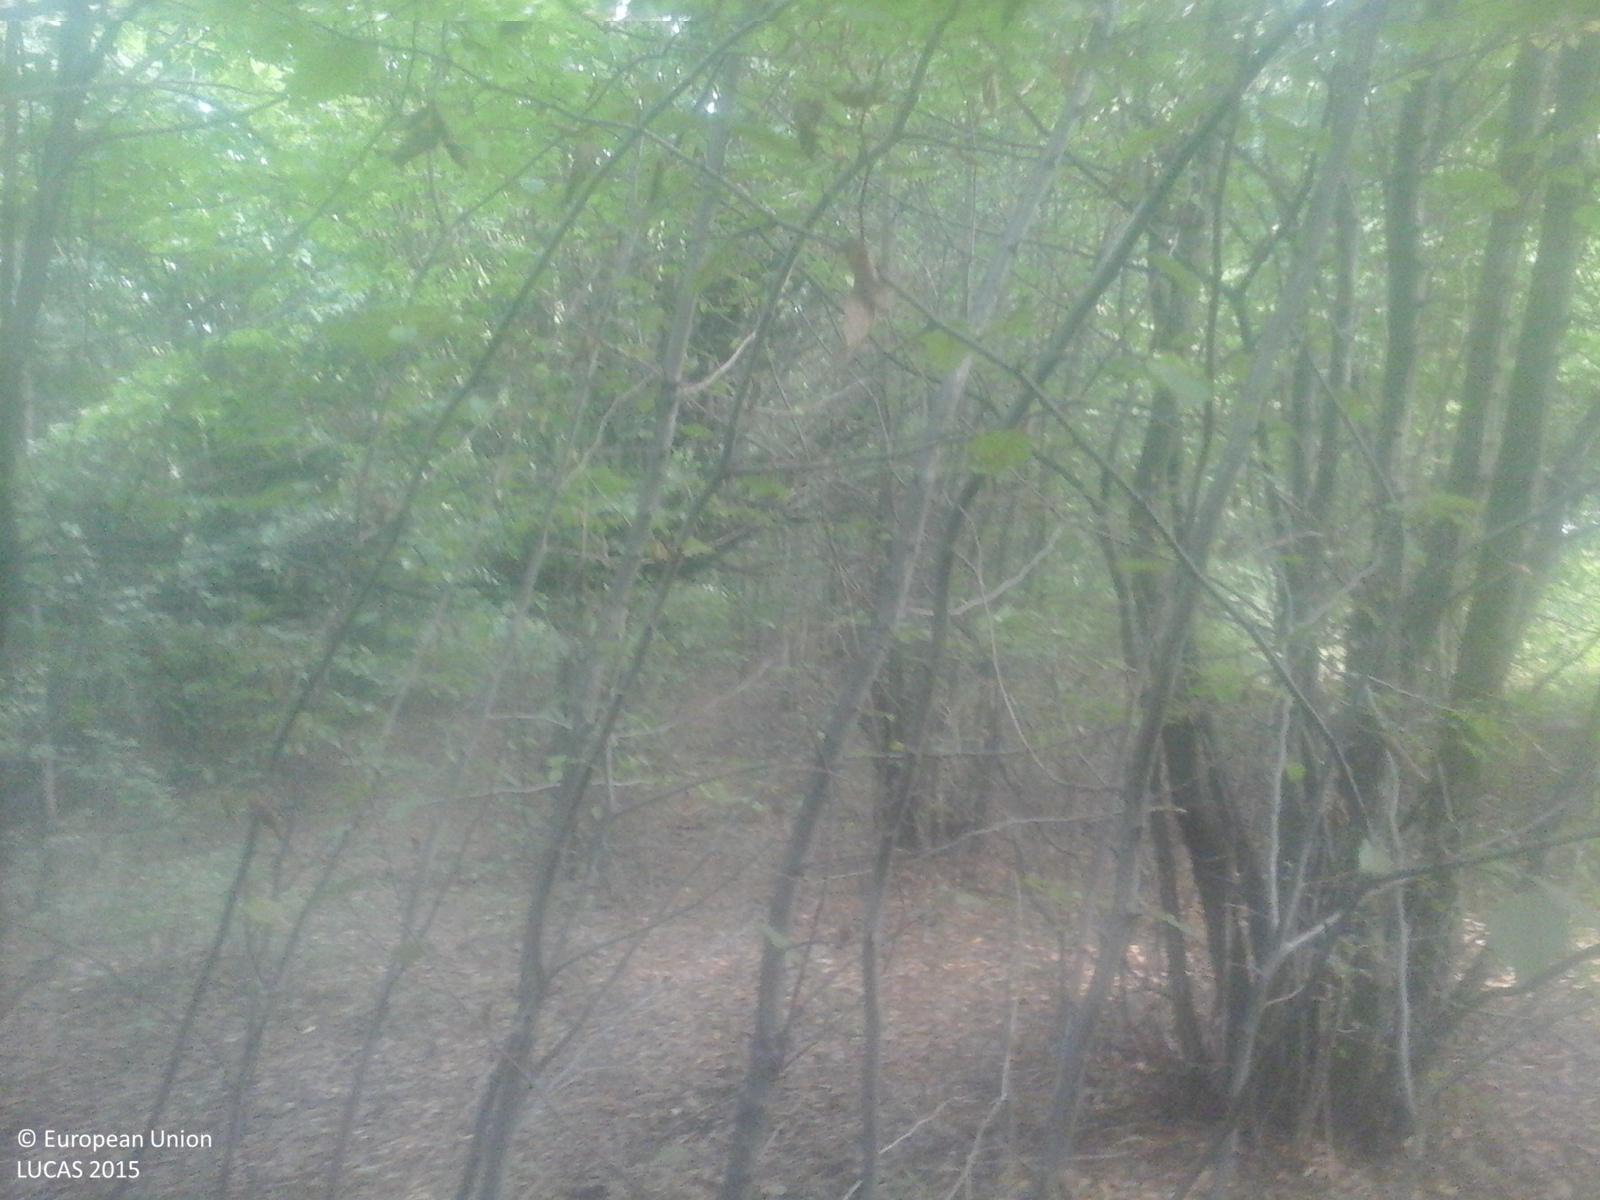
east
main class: Woodland
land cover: Broadleaved woodland
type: beech forest
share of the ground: > 75 %
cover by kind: broadleaved forest trees 100 %
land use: Forestry
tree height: > 5 m
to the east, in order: Broadleaved woodland; Grassland with sparse tree/shrub cover; Abandoned hedges; Grassland without tree/shrub cover
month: September
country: RO
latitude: 47.1389
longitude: 23.1587
